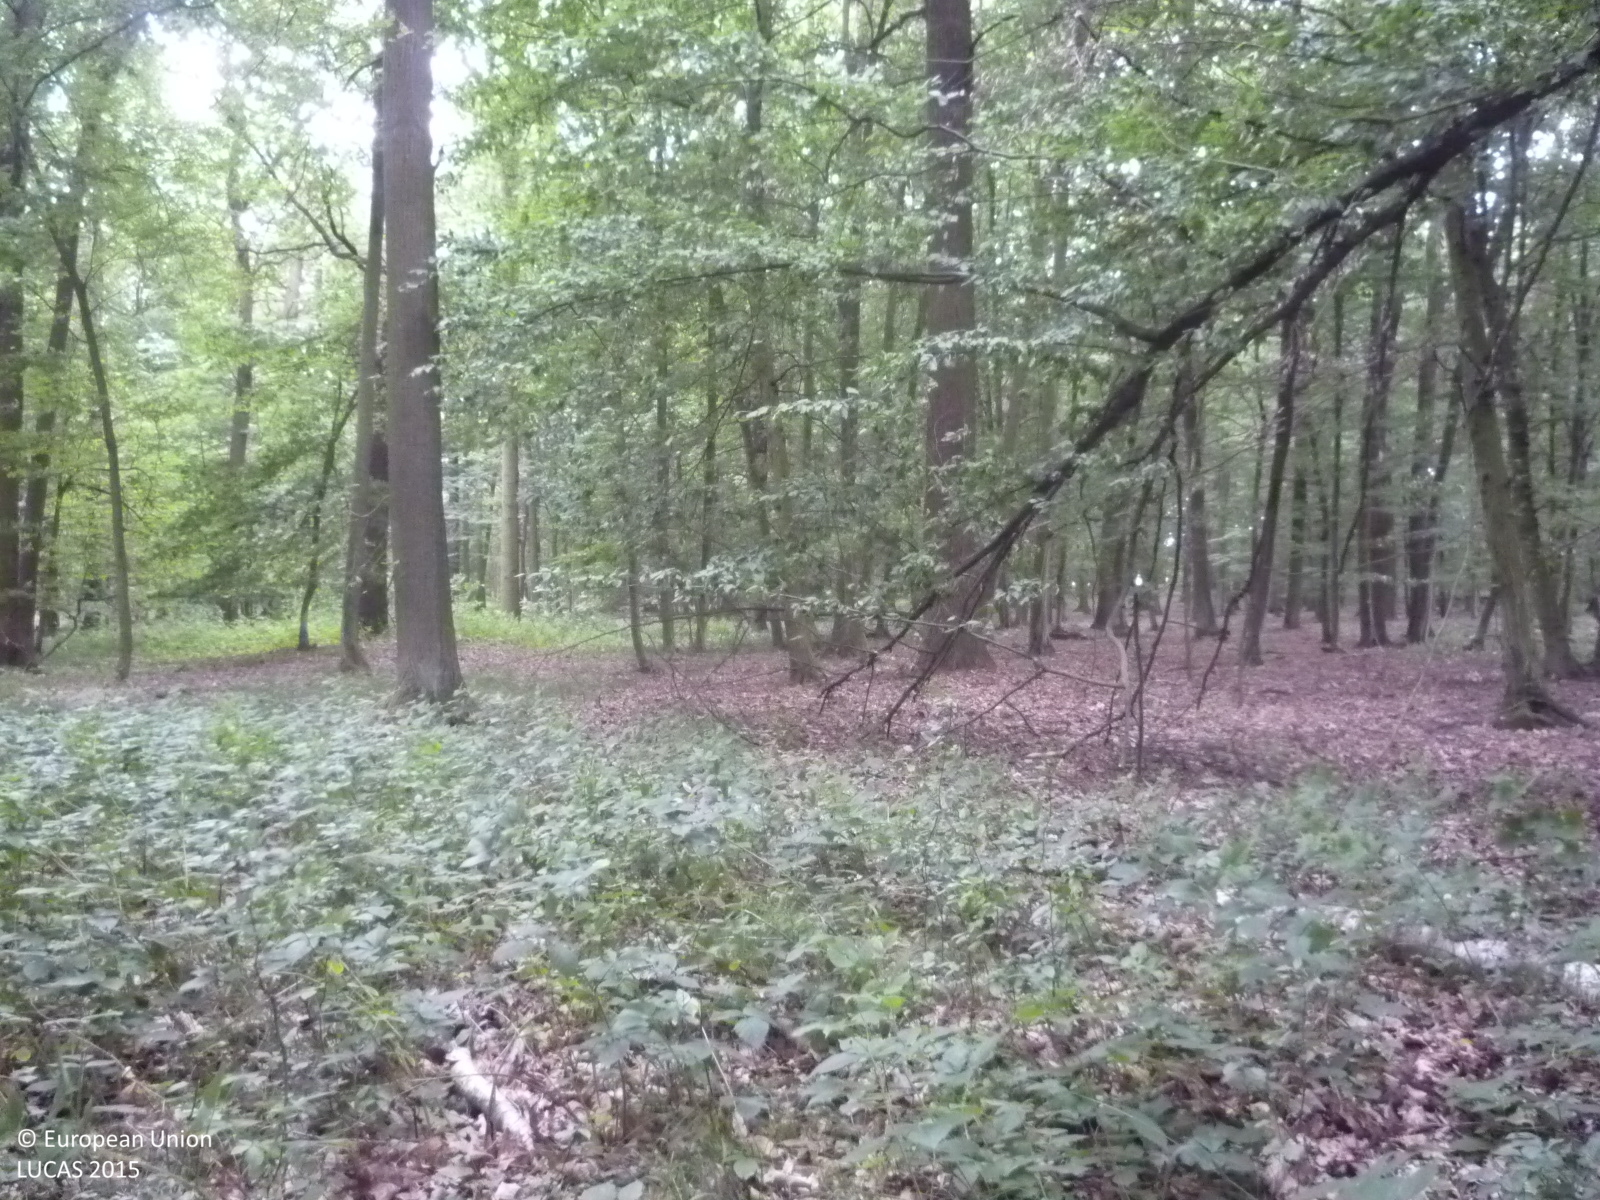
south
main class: Woodland
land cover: Broadleaved woodland
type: mesophytic deciduous forest
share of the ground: > 75 %
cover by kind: broadleaved forest trees 90 %, unconsolidated bare surface 10 %
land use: Forestry
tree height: > 5 m
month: July
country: CZ
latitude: 50.2781
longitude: 15.6597
